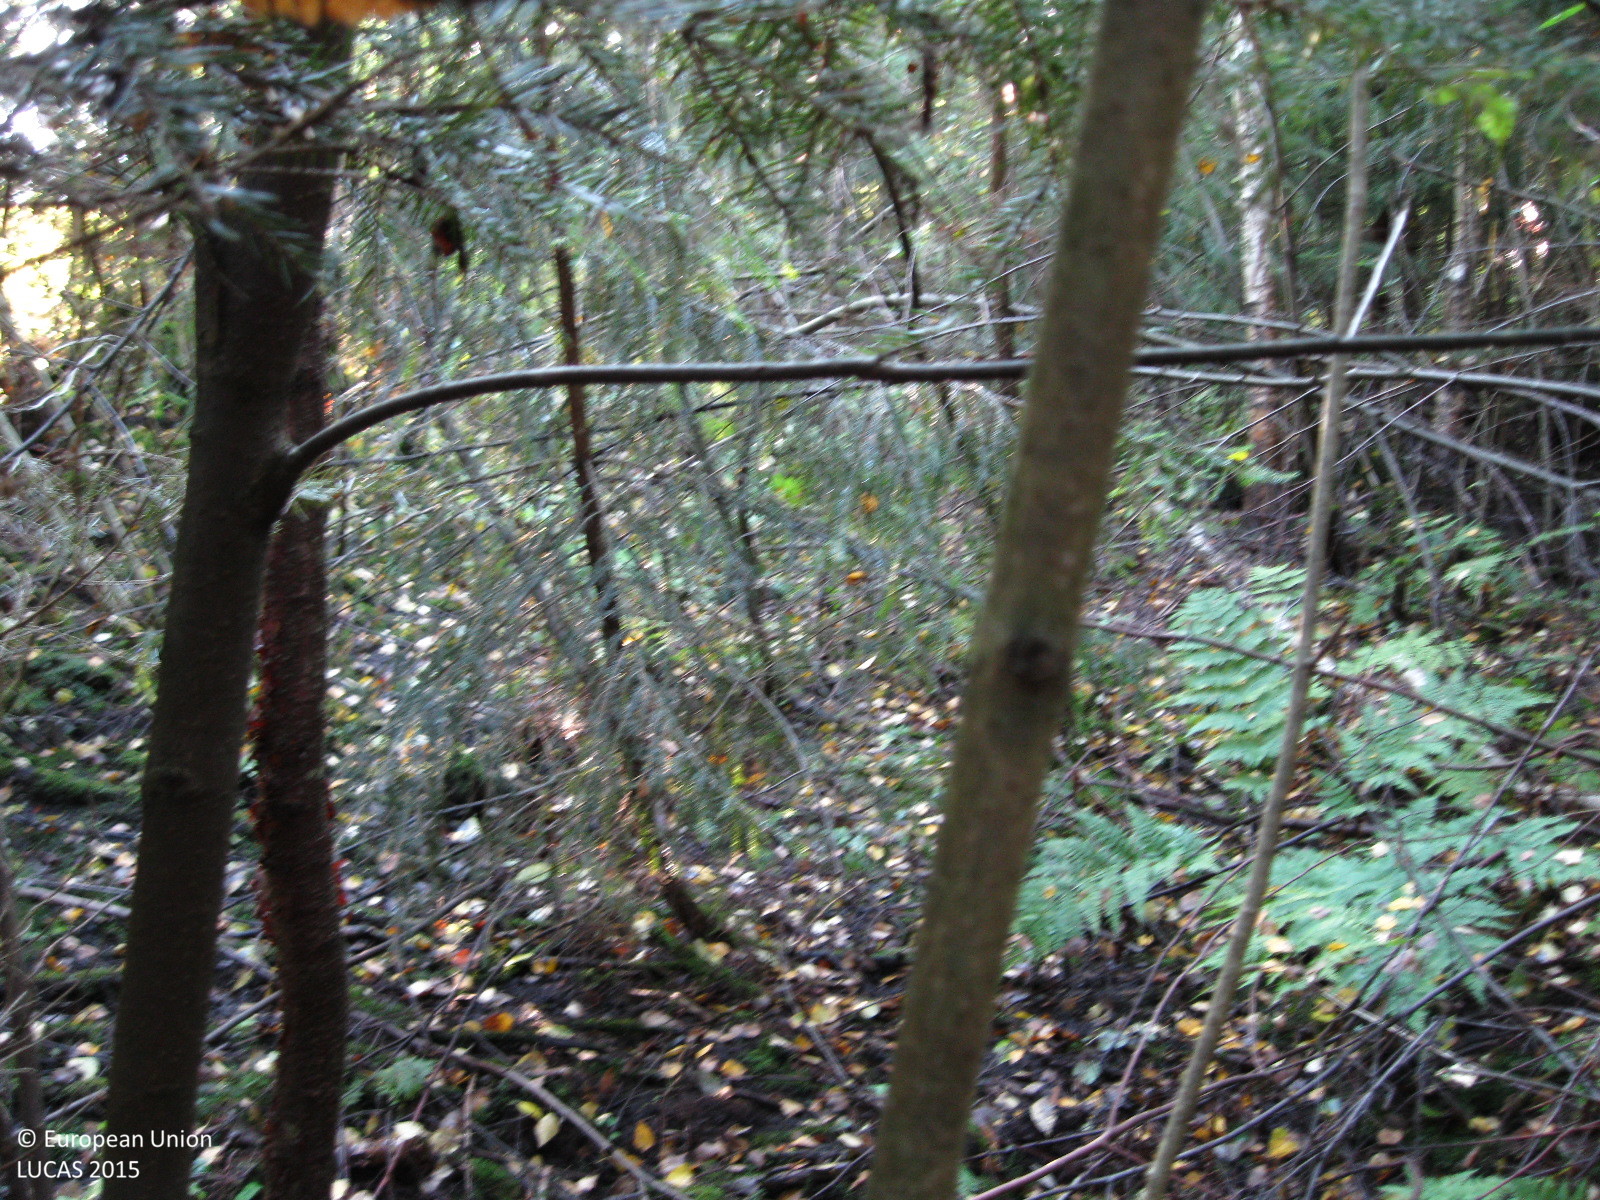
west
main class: Woodland
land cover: Spruce dominated mixed woodland
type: boreal forest
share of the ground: > 75 %
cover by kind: coniferous forest trees 50 %, broadleaved forest trees 45 %, herbaceous plants 5 %
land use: Forestry
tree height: > 5 m
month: September
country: FI
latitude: 60.5555
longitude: 24.7555
